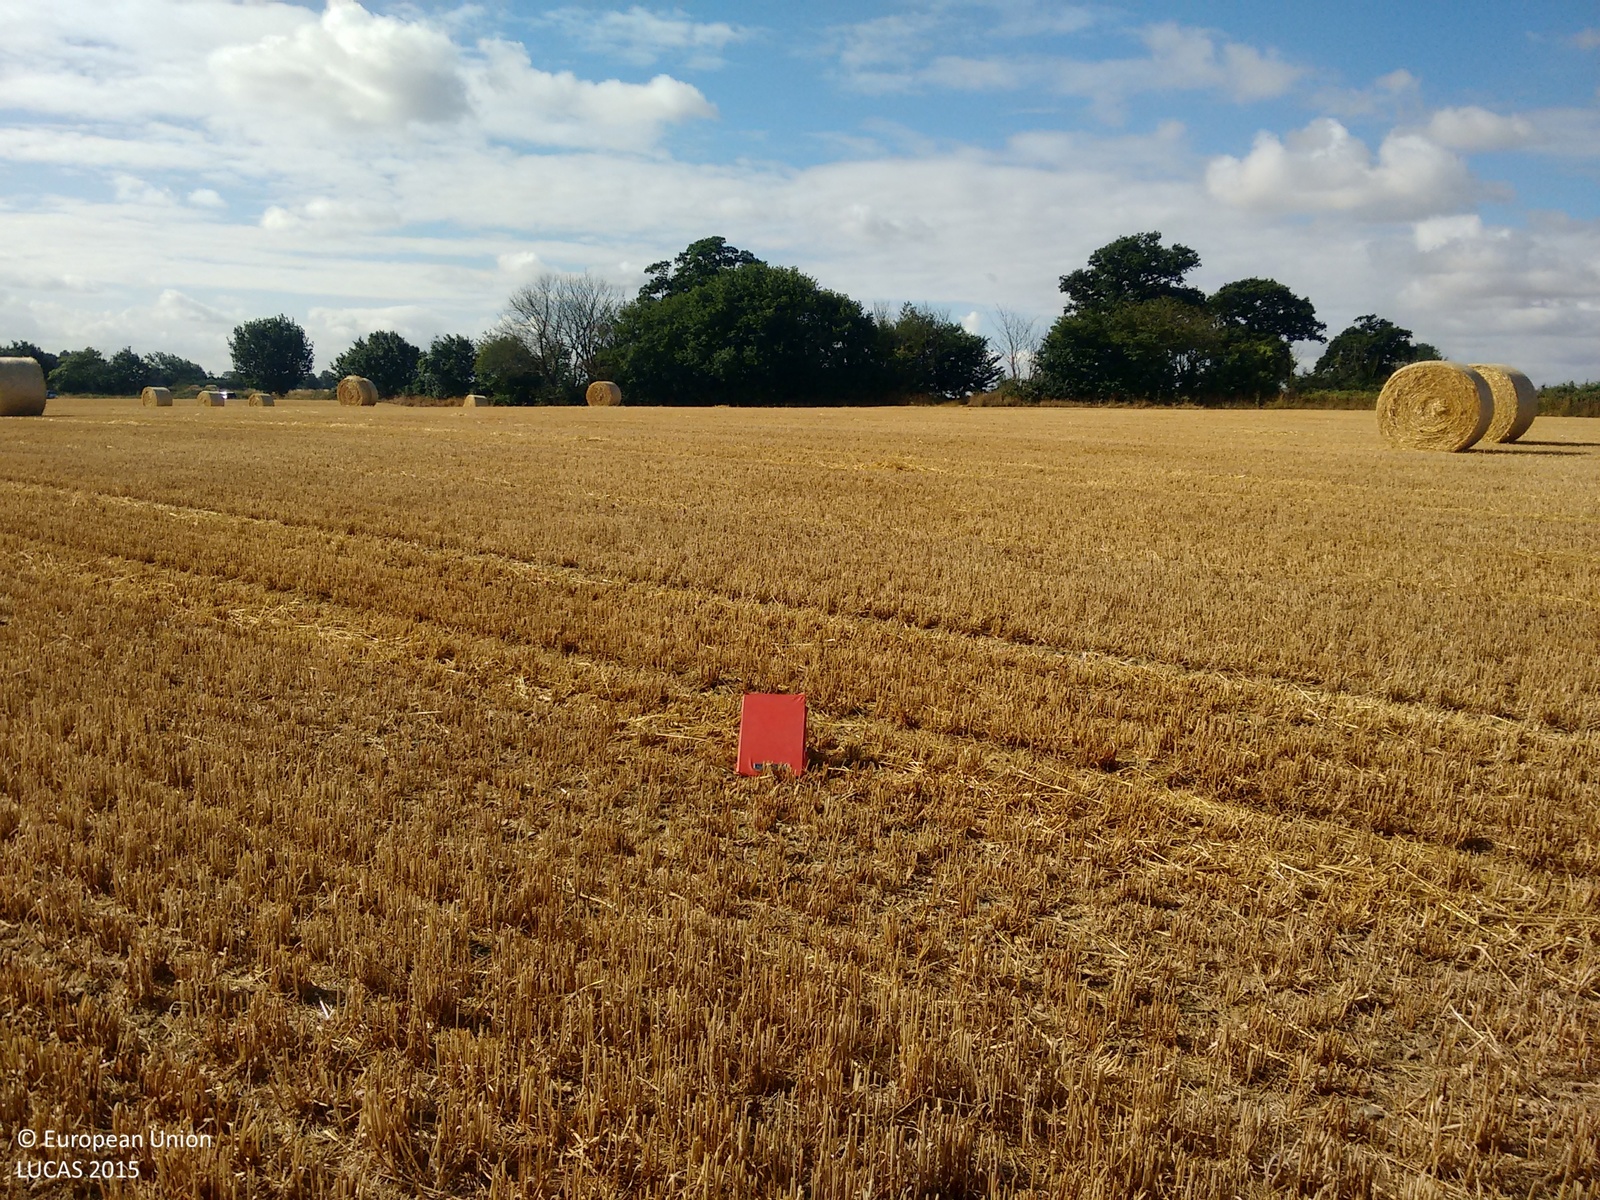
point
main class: Cropland
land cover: Barley
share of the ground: > 75 %
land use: Agriculture (excluding fallow land and kitchen gardens)
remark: Harvested field
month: July
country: GB
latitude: 51.8394
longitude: 0.5825
